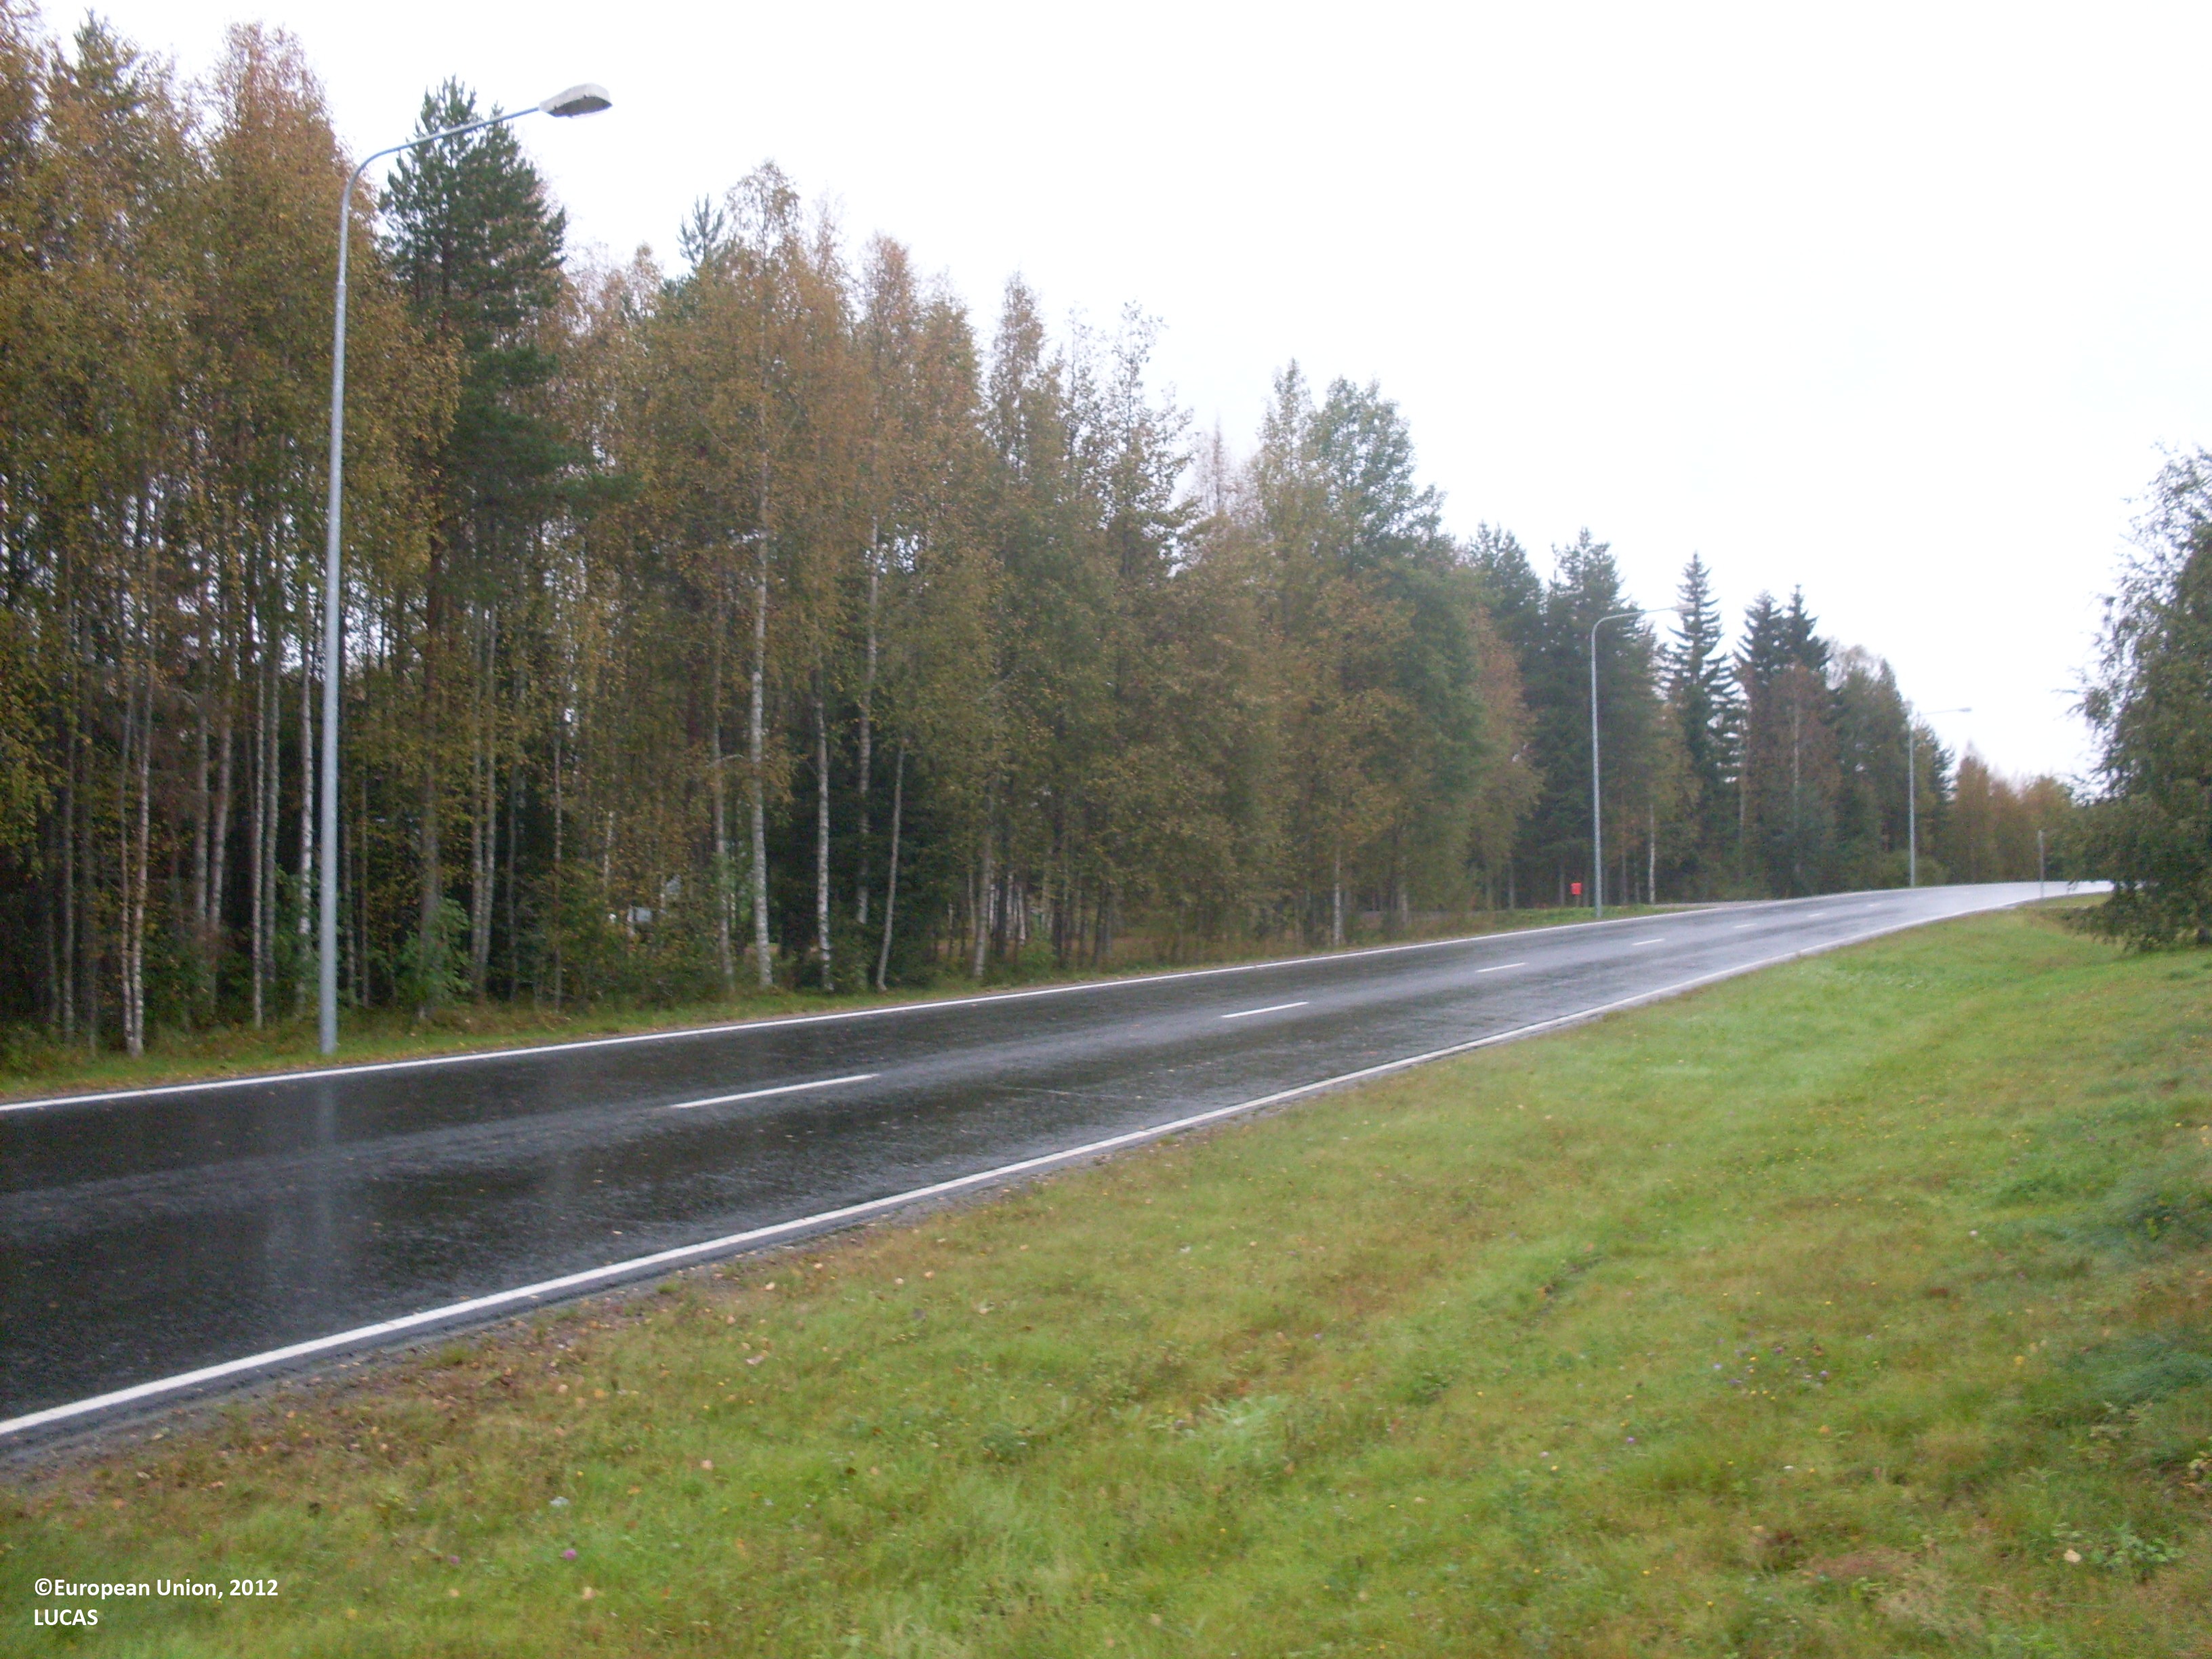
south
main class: Grassland
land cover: Grassland without tree/shrub cover
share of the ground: > 75 %
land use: Road transport
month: September
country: FI
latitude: 64.1183
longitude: 29.5417
